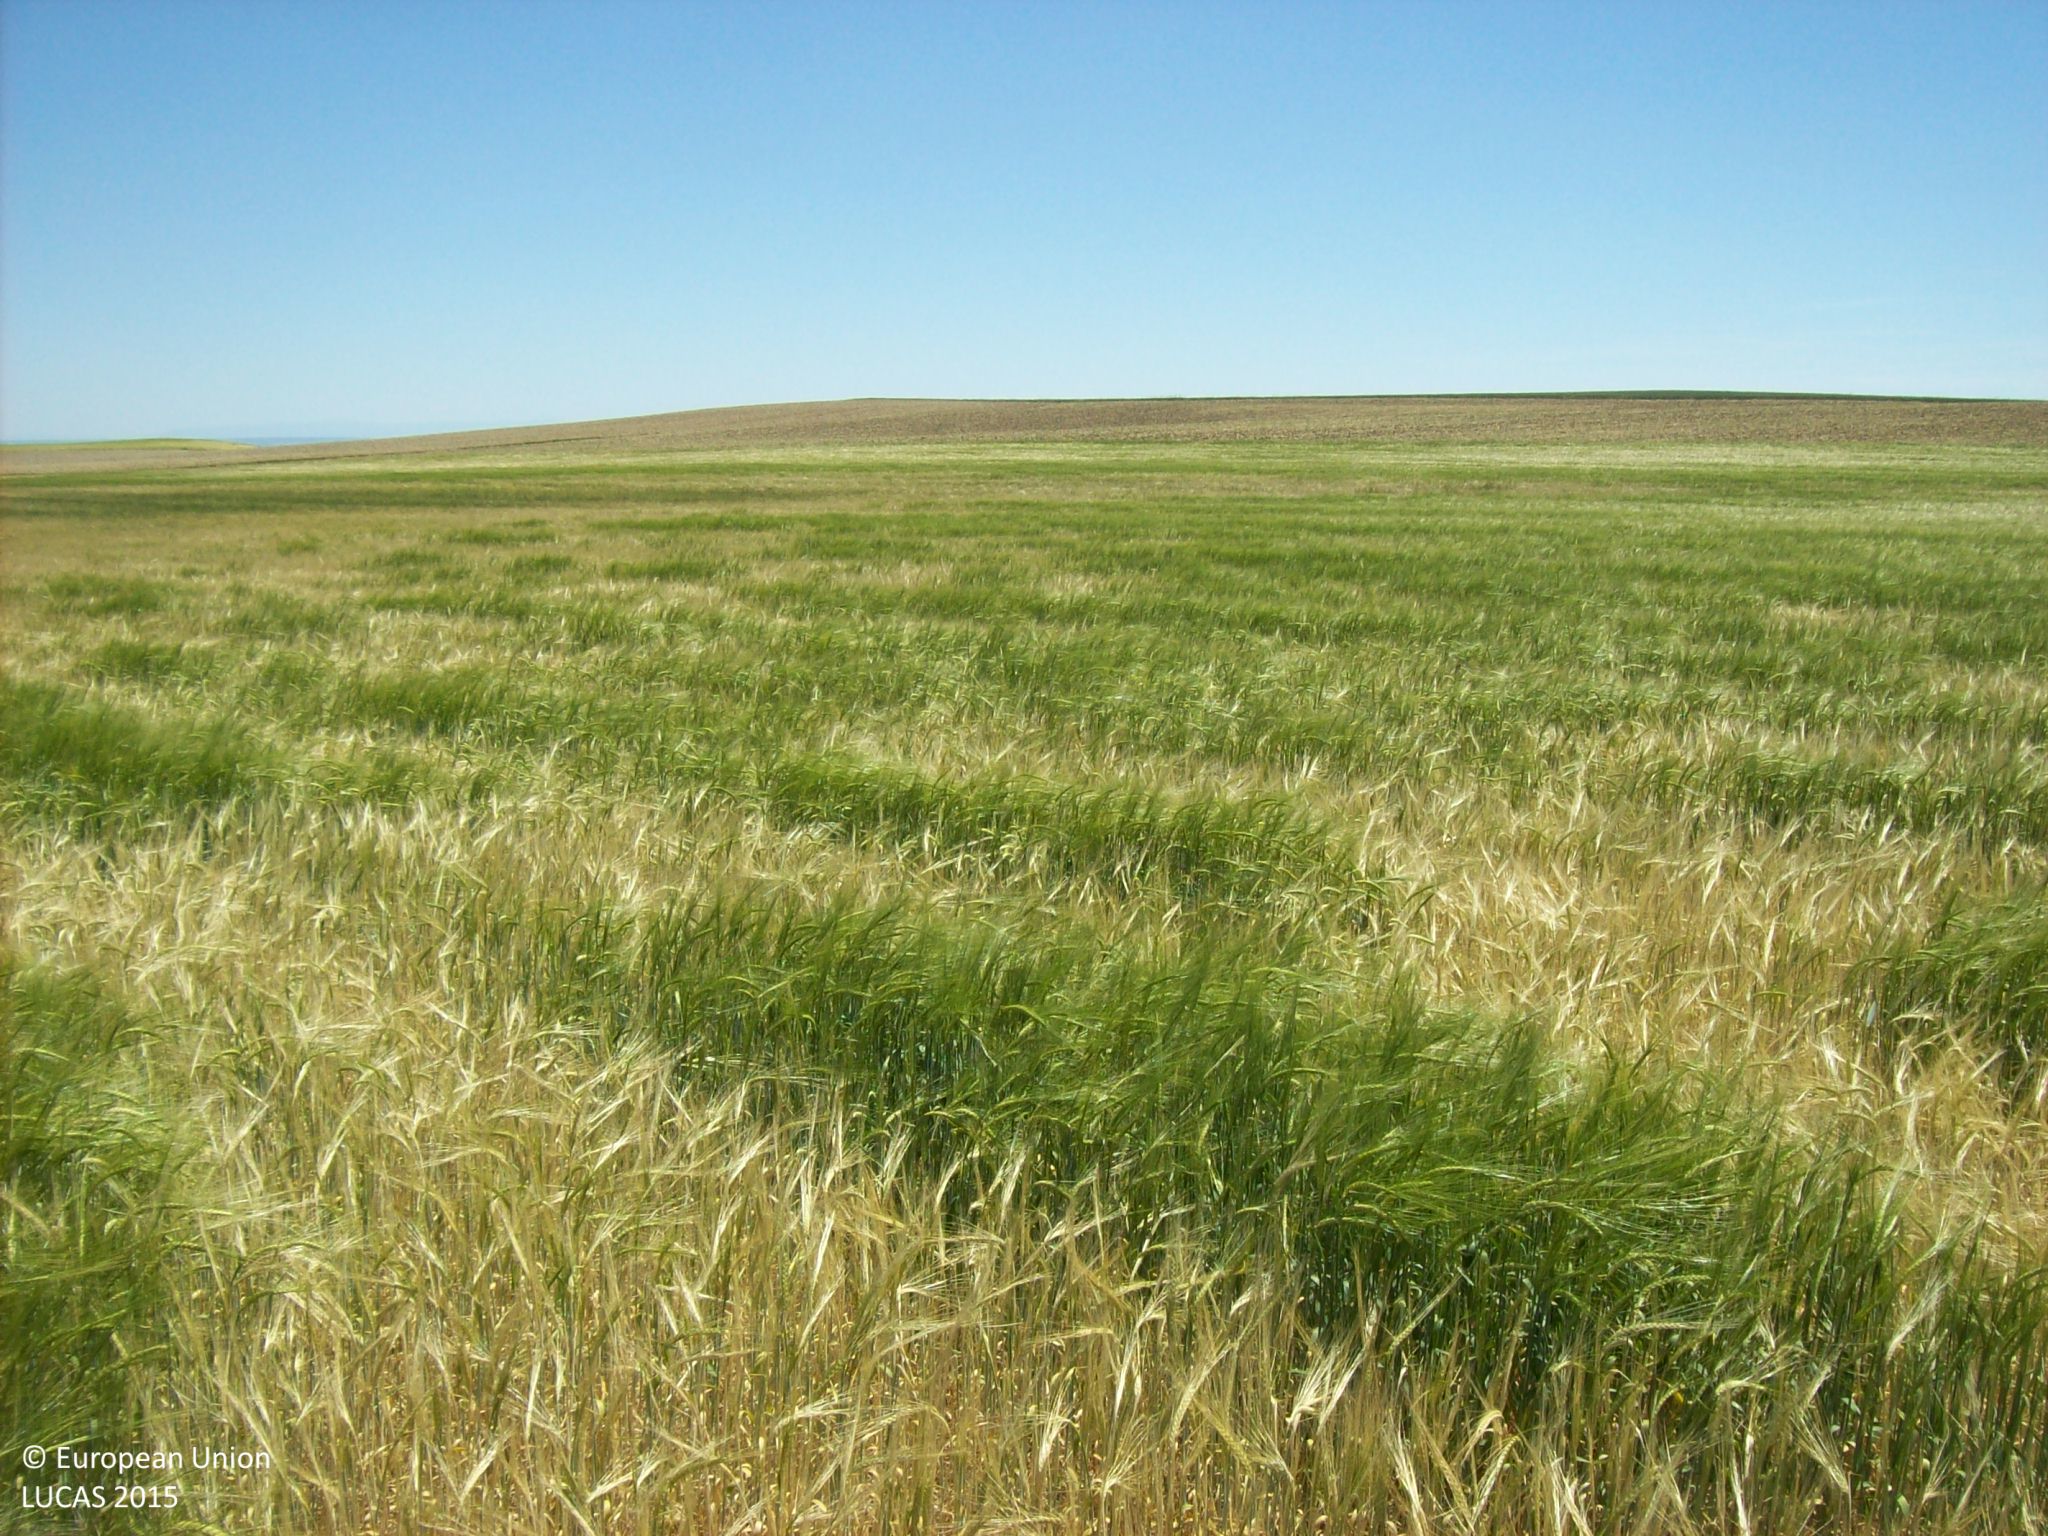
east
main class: Cropland
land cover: Barley
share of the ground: > 75 %
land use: Agriculture (excluding fallow land and kitchen gardens)
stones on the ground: < 10 %
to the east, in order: Barley; Grass margins; Other bare soil; Grass margins; Other bare soil
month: May
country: ES
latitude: 40.8372
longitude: -4.9698
